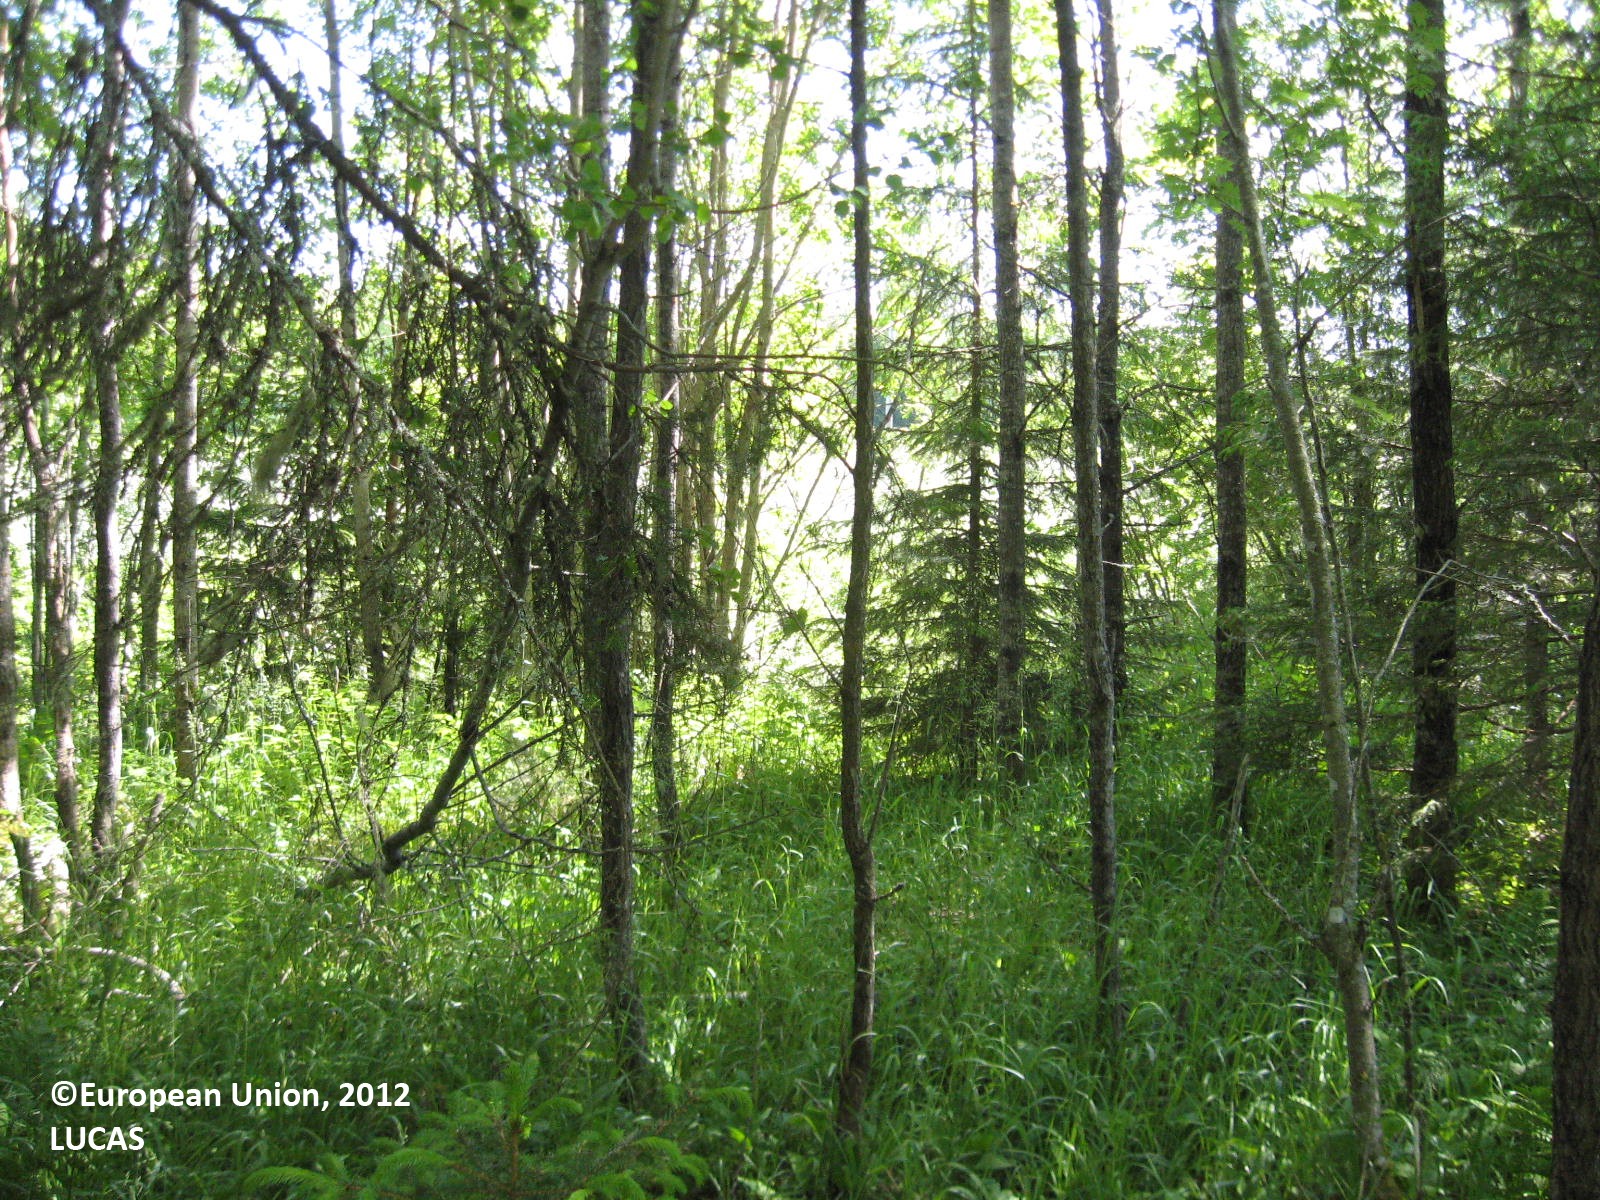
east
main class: Woodland
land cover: Spruce dominated mixed woodland
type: boreal forest
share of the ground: > 75 %
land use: Forestry
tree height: > 5 m
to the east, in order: Spruce dominated mixed woodland; Shruby margins; Rye; Grass margins; Ditches and canals; Temporary grasslands; Ditches and canals; Temporary grasslands; Ditches and canals; Spruce dominated coniferous woodland; Shrubland without tree cover; Spruce dominated coniferous woodland; Ditches and canals; Paved roads, cycling and walking lanes; Ditches and canals; Spruce dominated coniferous woodland
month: June
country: FI
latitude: 62.8729
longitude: 21.8592
